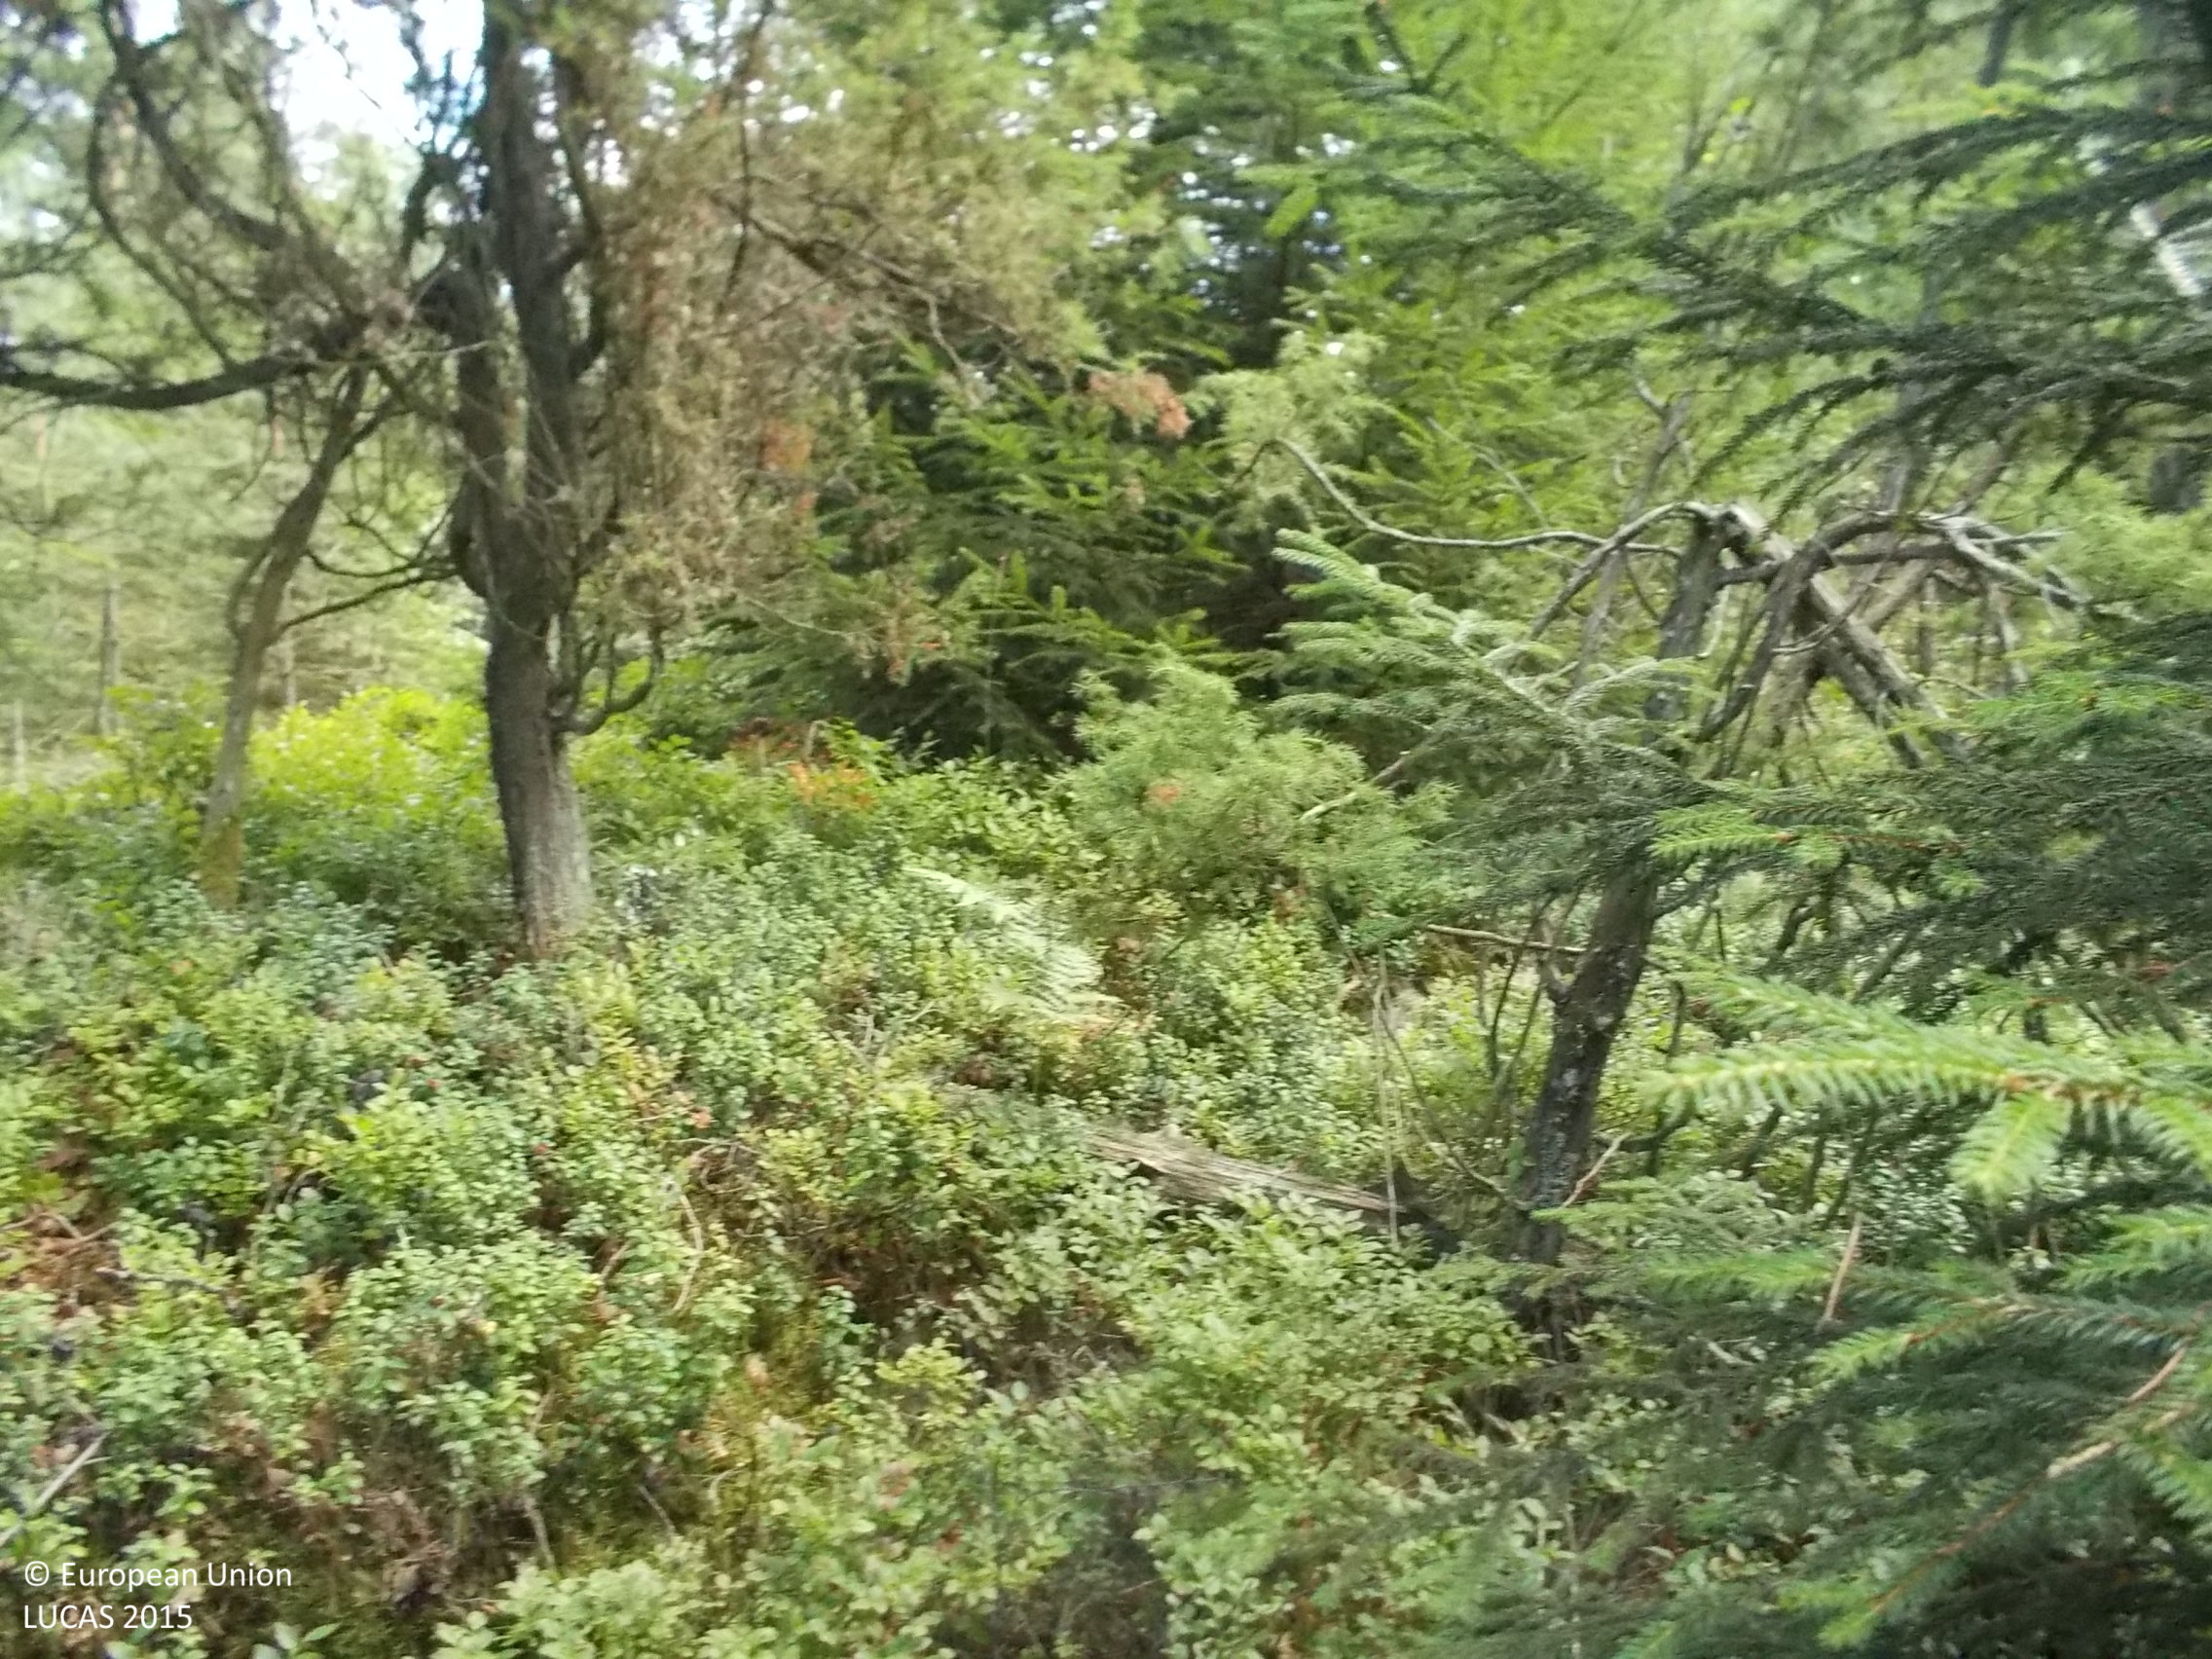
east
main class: Woodland
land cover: Spruce dominated mixed woodland
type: boreal forest
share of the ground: > 75 %
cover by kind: coniferous forest trees 60 %, broadleaved forest trees 25 %, shrubs 10 %, lichens and mosses 5 %
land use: Forestry
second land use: Sport
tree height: > 5 m
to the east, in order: Spruce dominated mixed woodland; Pine dominated mixed woodland; Inland fresh water bodies; Pine dominated mixed woodland; Spruce dominated coniferous woodland
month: August
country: SE
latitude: 57.5529
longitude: 12.2525
